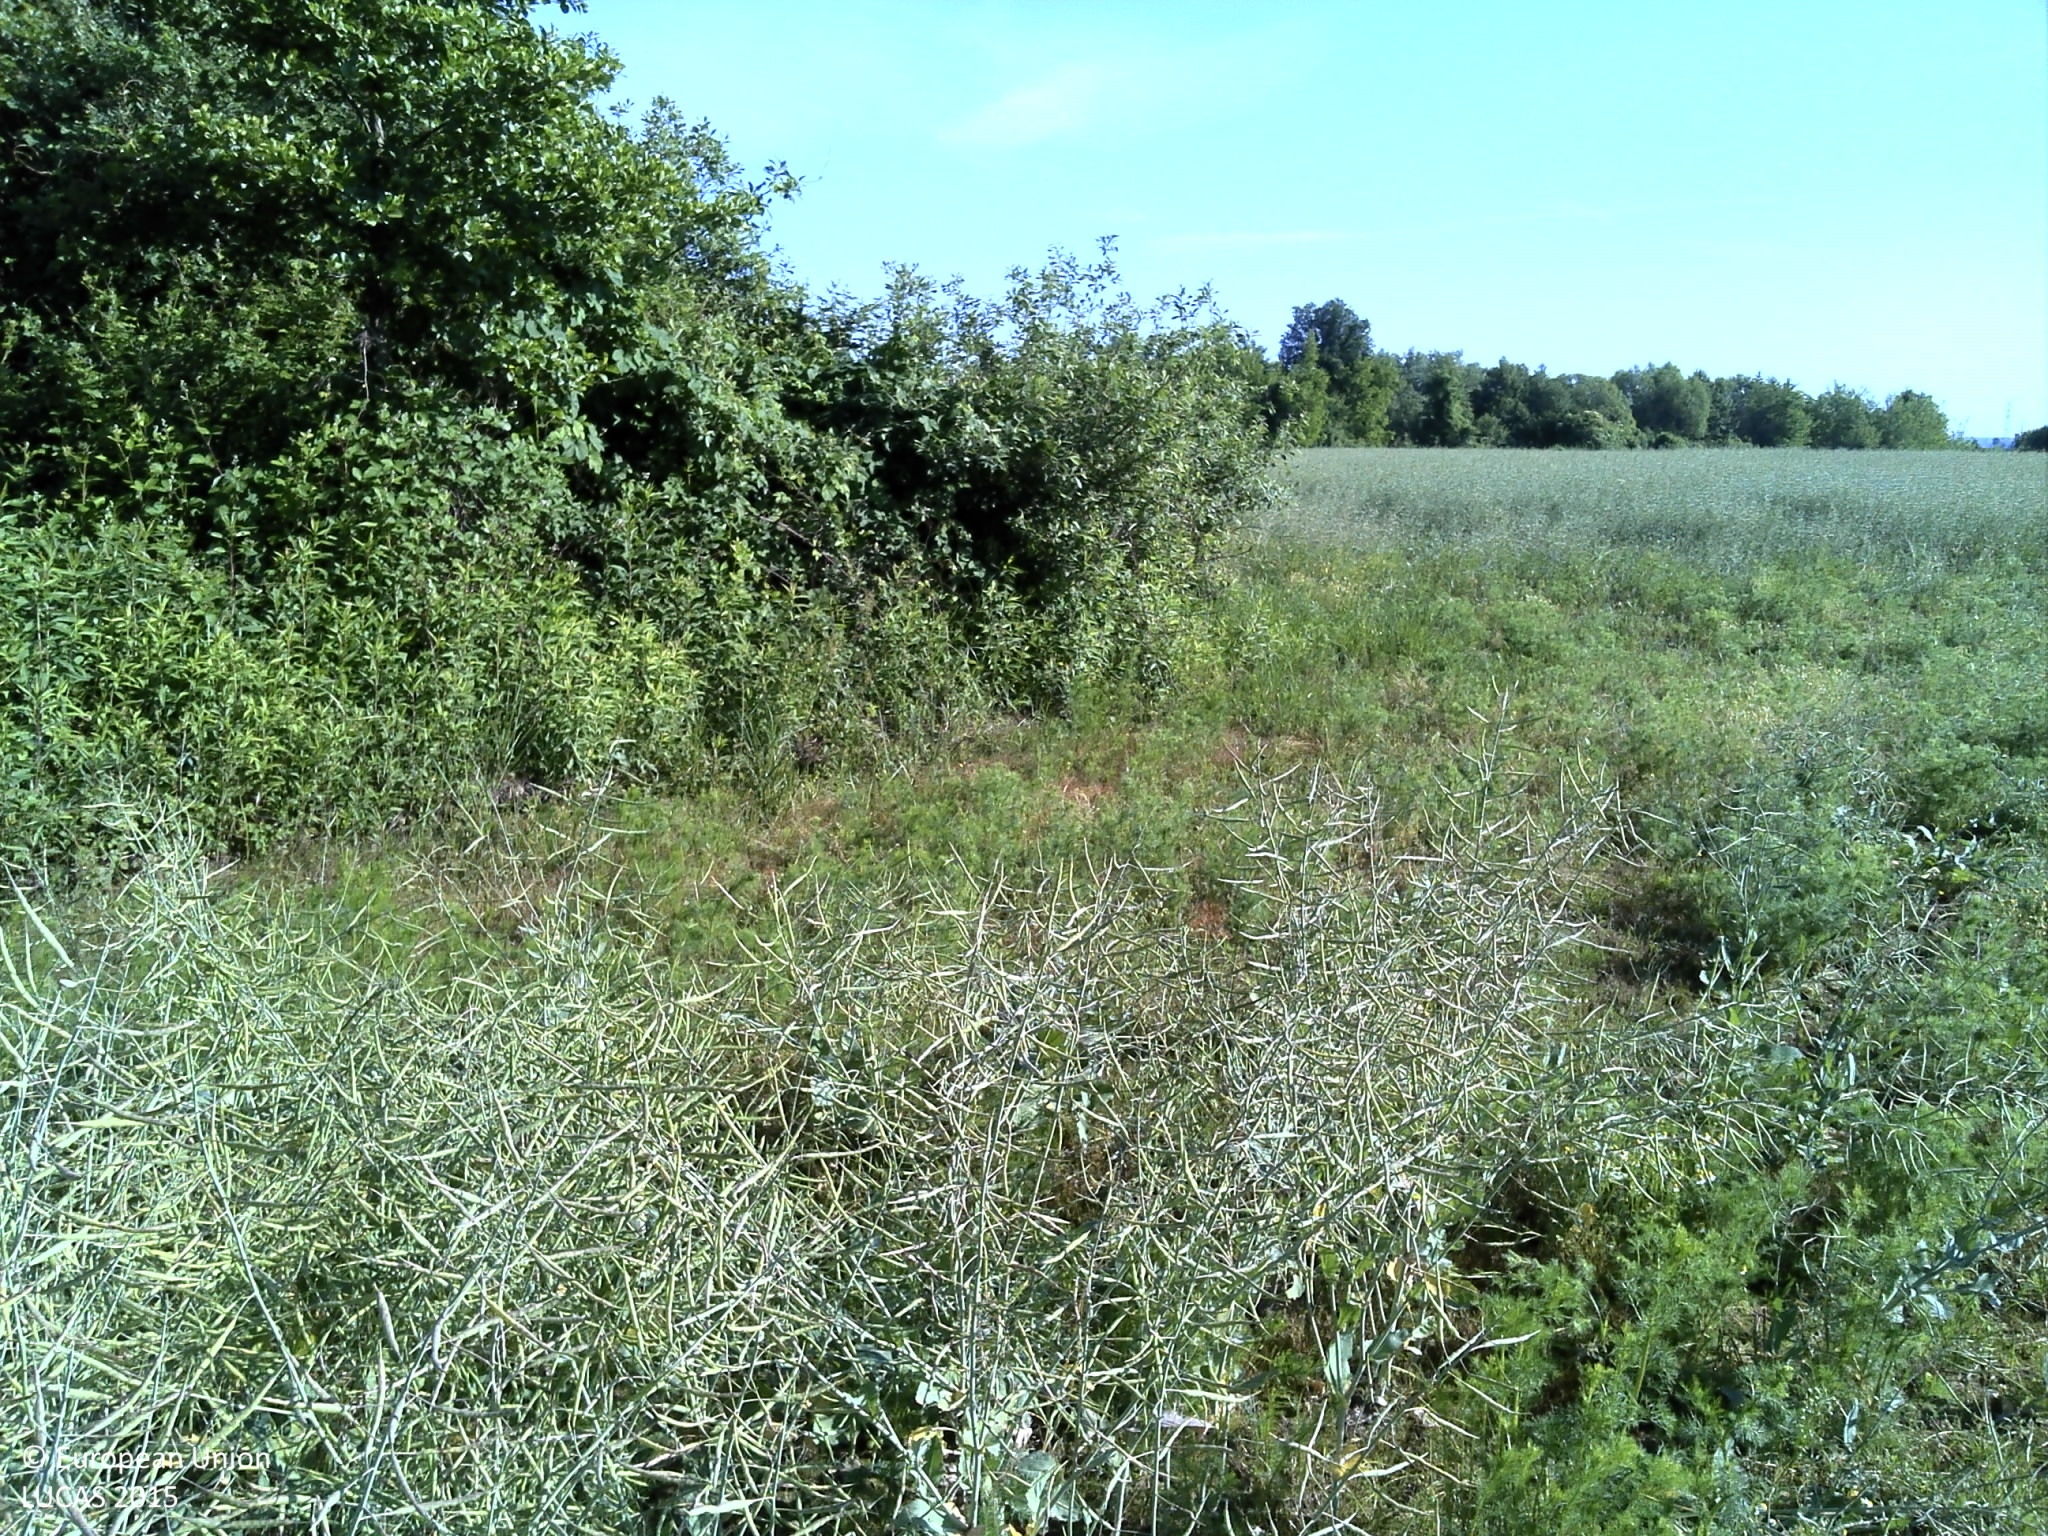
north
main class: Cropland
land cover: Rape and turnip rape
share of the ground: > 75 %
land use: Agriculture (excluding fallow land and kitchen gardens)
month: May
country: HR
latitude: 45.5694
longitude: 17.9094
